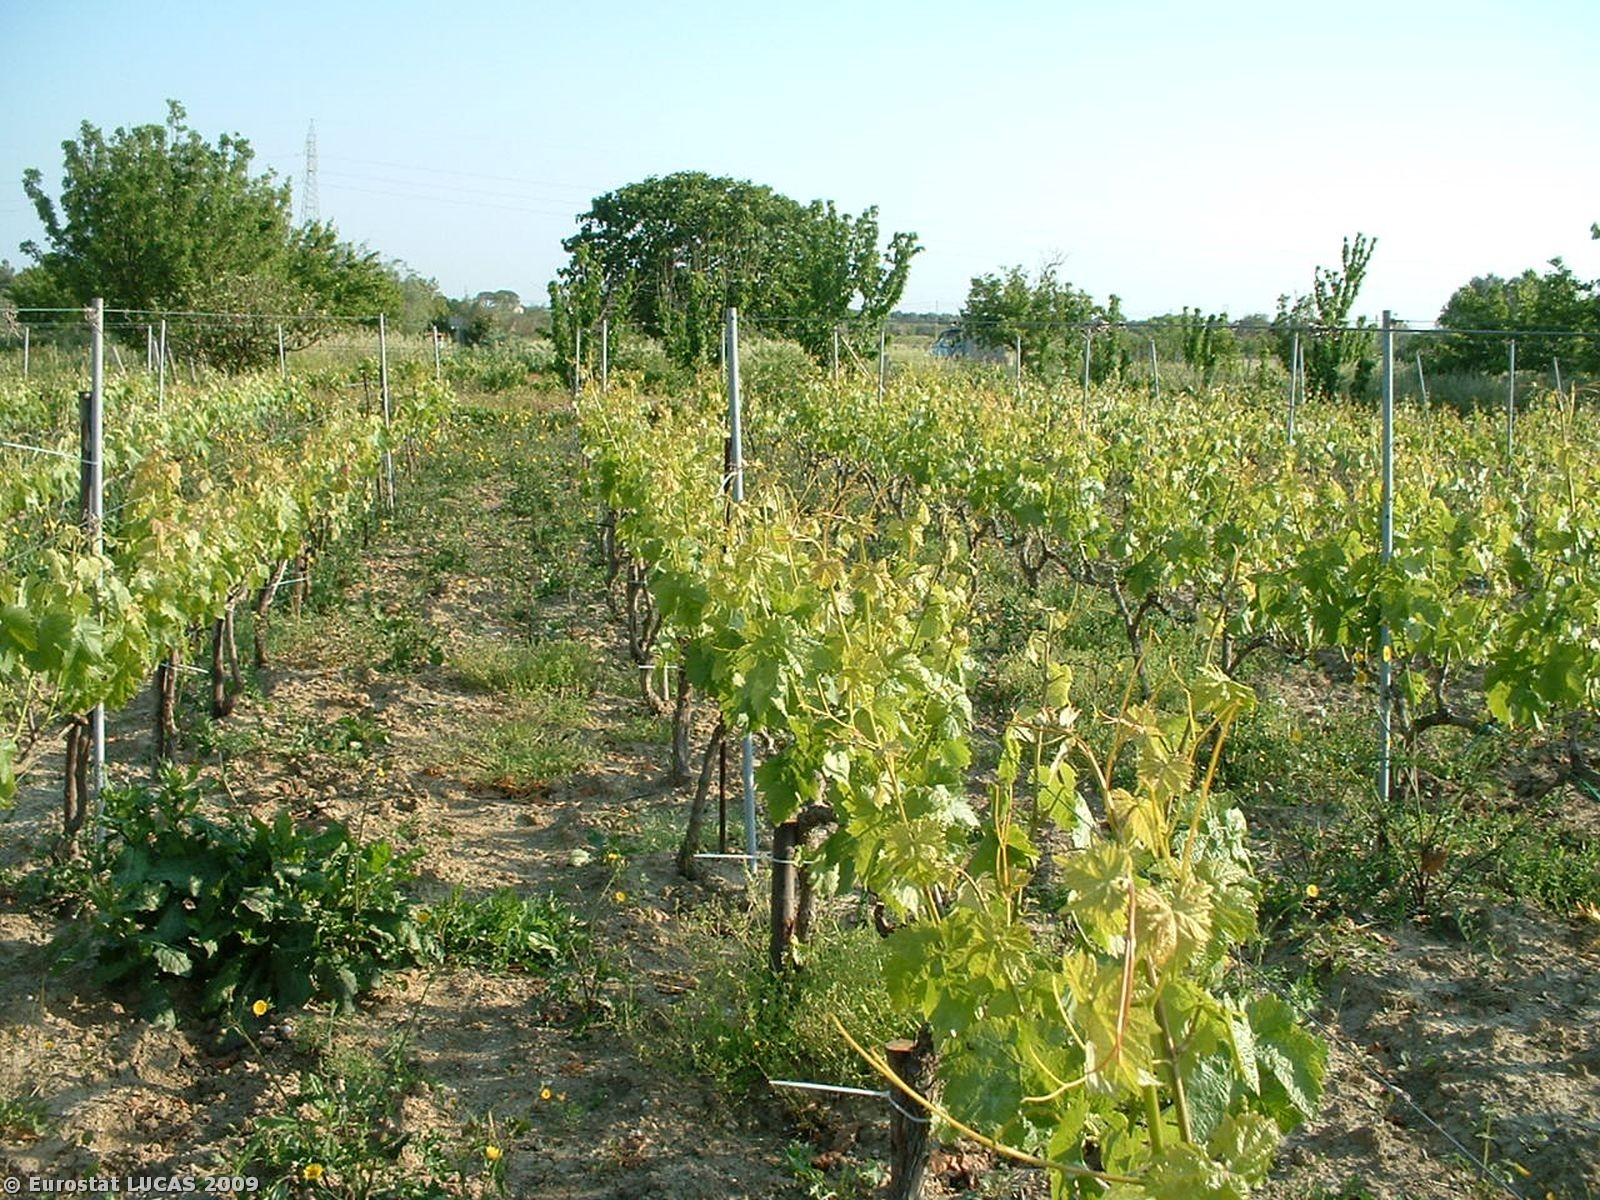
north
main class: Cropland
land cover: Vineyards
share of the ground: 25 - 50 %
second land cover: Bare land
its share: > 75 %
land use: Agriculture (excluding fallow land and kitchen gardens)
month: May
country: IT
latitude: 40.1493
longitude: 18.1089
